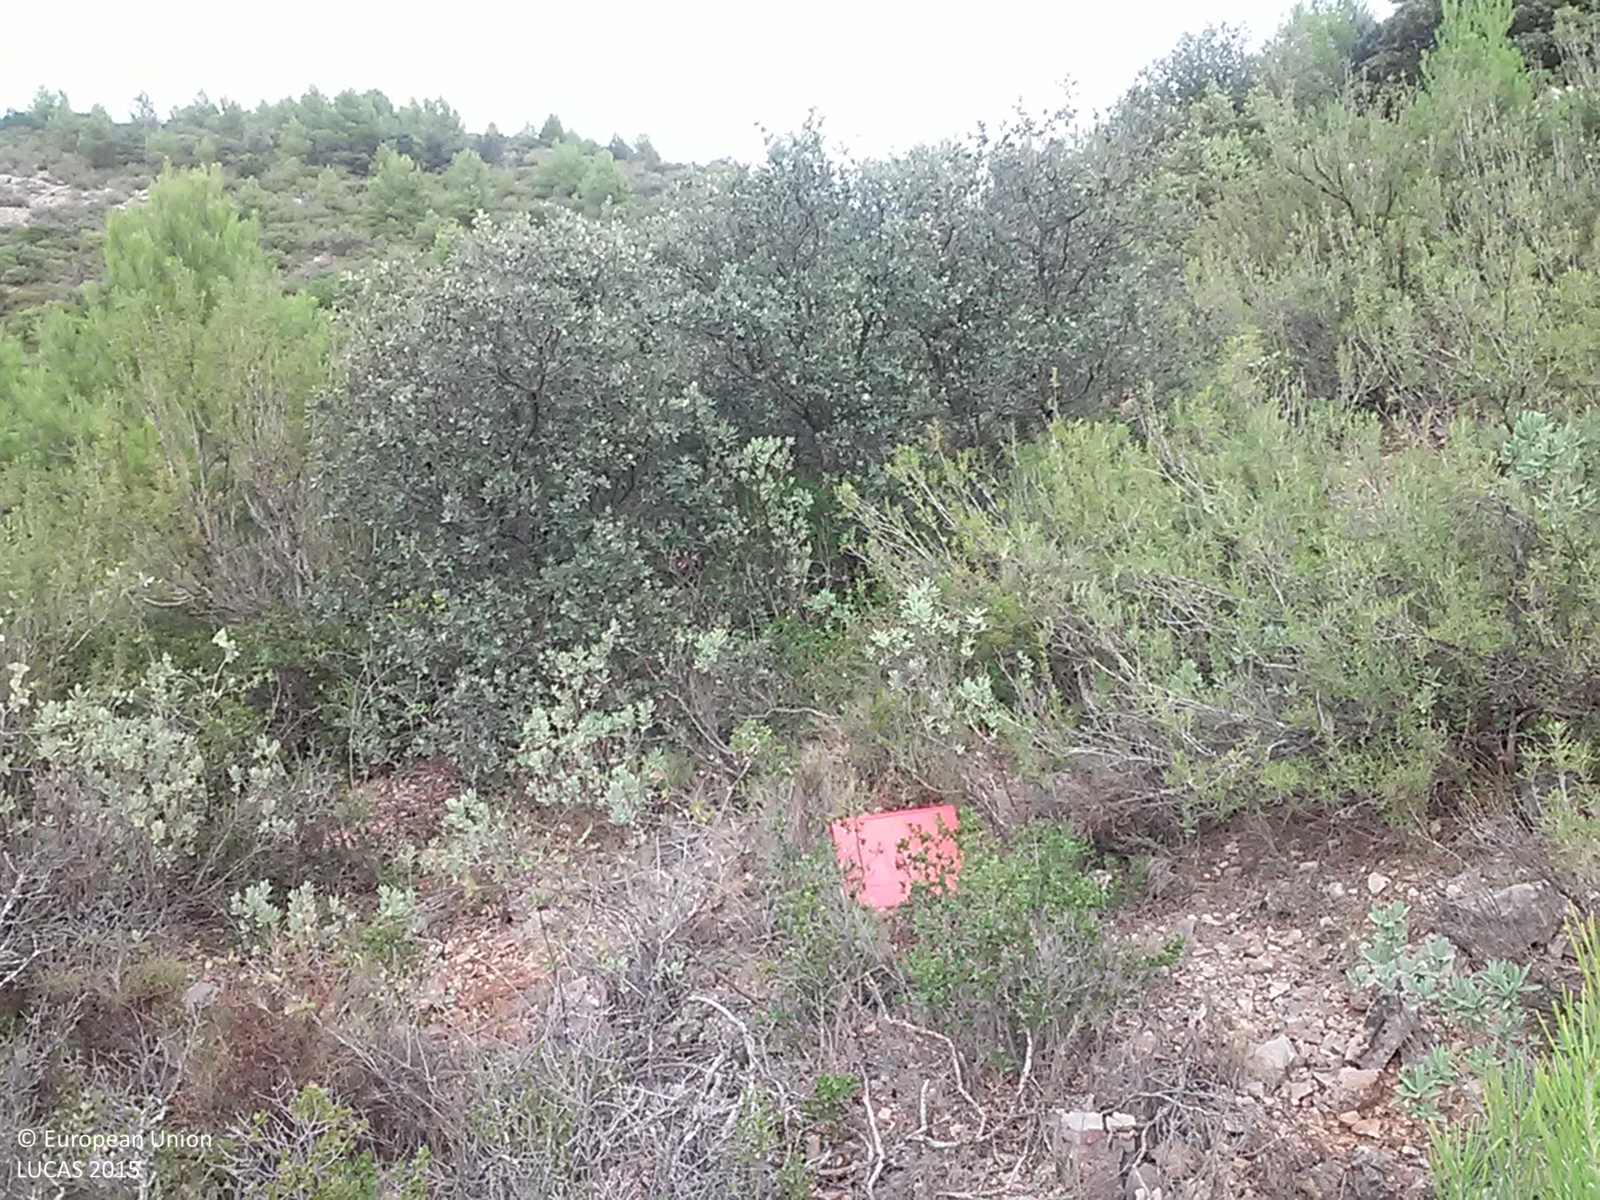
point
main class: Shrubland
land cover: Shrubland with sparse tree cover
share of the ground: > 75 %
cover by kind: shrubs 95 %, broadleaved forest trees 5 %
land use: Semi-natural and natural areas not in use
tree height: < 5 m
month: September
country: ES
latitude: 41.2522
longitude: 0.7901
